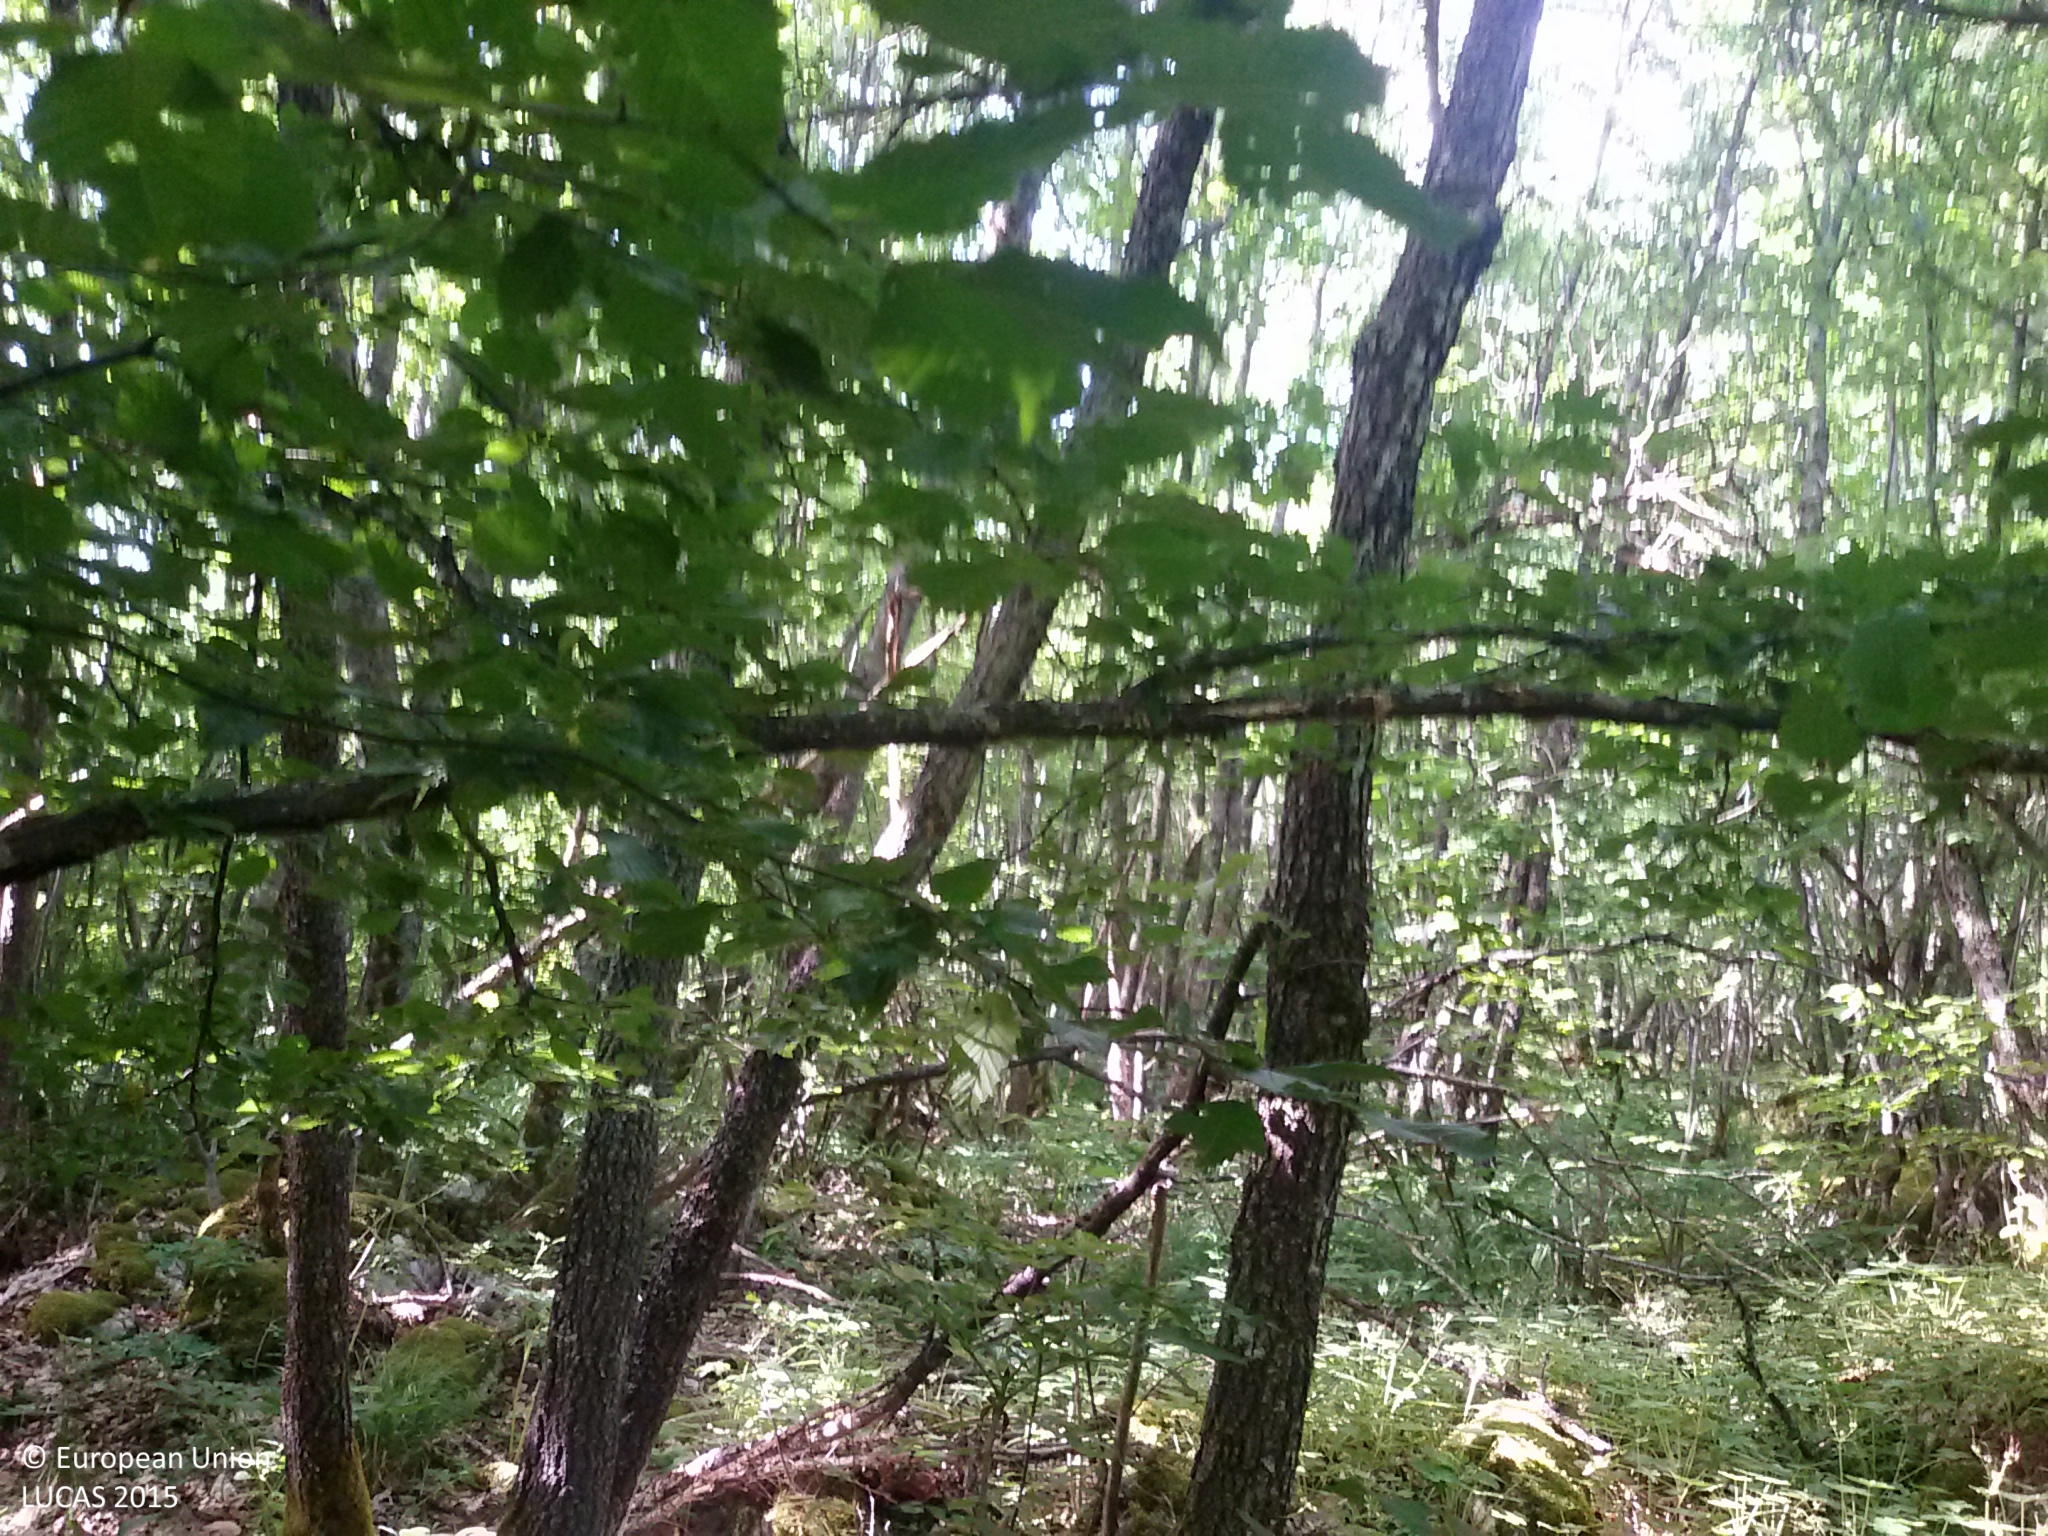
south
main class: Woodland
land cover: Broadleaved woodland
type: thermophilous deciduous forest
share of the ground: > 75 %
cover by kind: broadleaved forest trees 80 %, consolidated bare surface 10 %, lichens and mosses 5 %, unconsolidated bare surface 5 %
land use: Semi-natural and natural areas not in use
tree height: > 5 m
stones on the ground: < 10 %
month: June
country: HR
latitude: 44.5403
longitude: 15.6445
